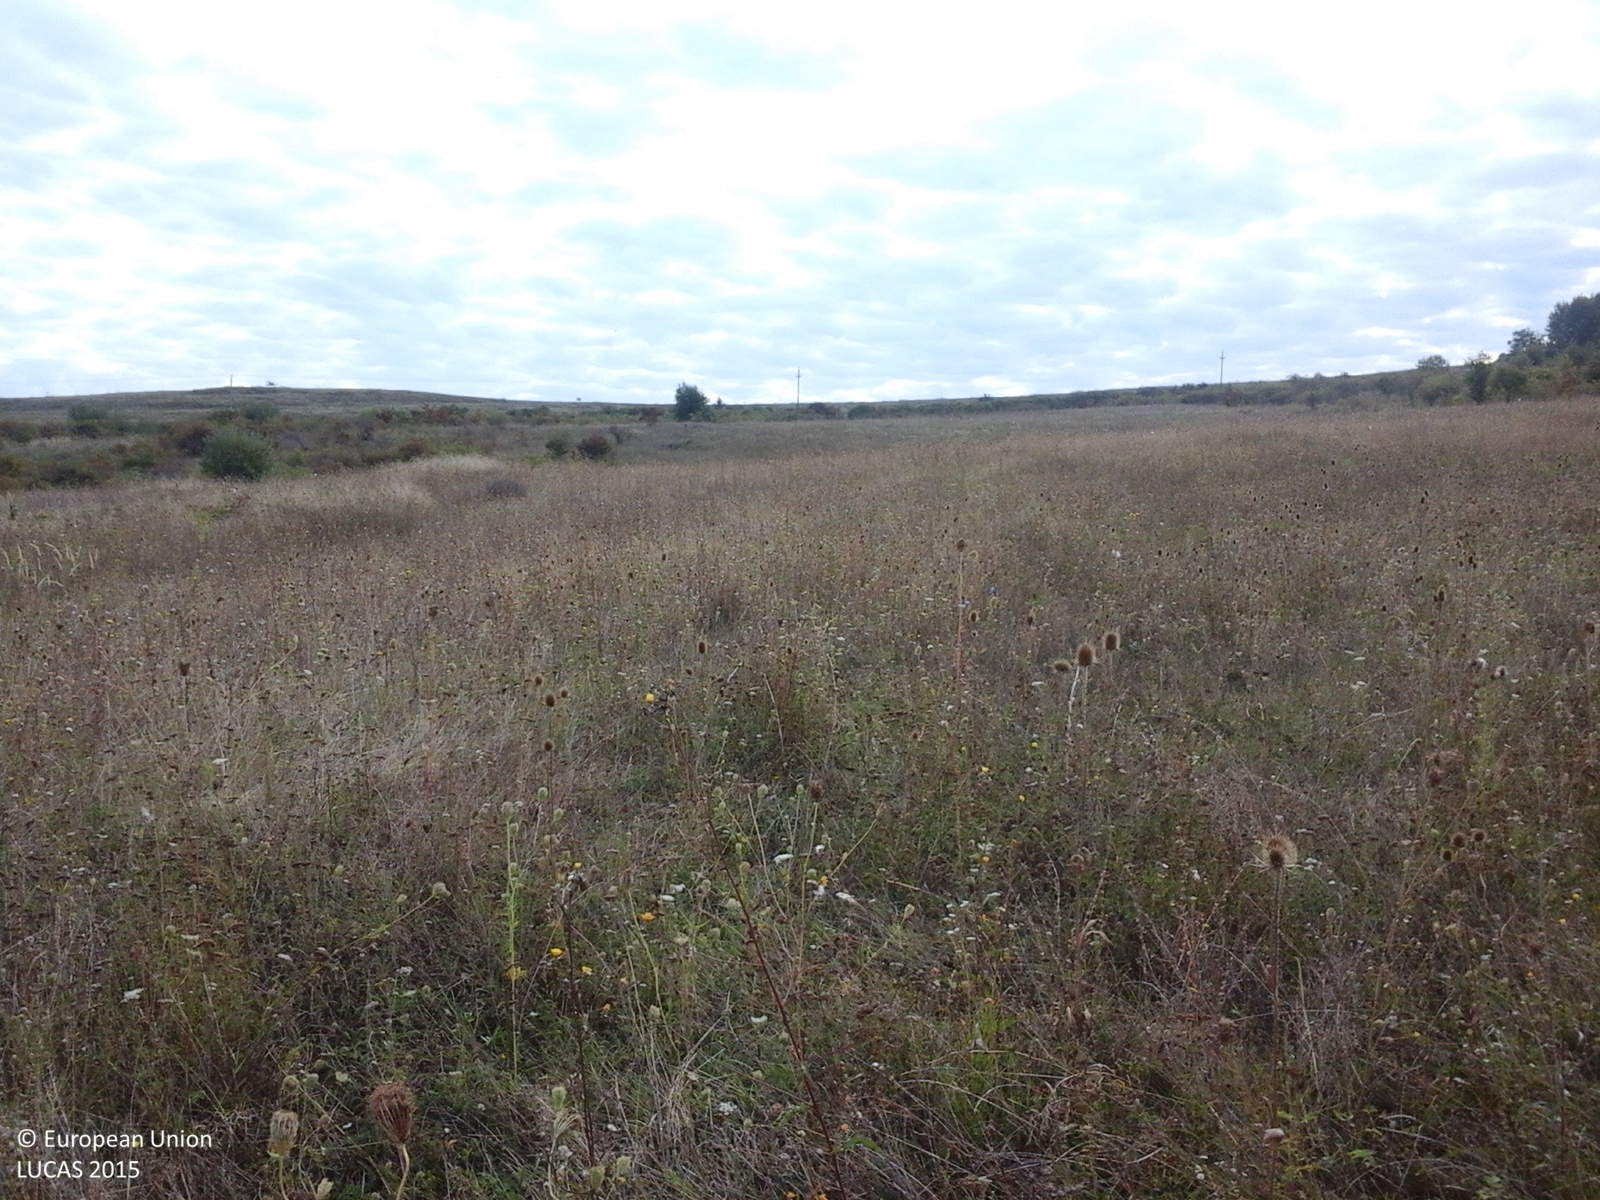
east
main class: Grassland
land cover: Grassland without tree/shrub cover
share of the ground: > 75 %
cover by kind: herbaceous plants 100 %
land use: Agriculture (excluding fallow land and kitchen gardens)
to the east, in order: Grassland without tree/shrub cover; Tracks; Spontaneously vegetated surfaces
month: September
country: RO
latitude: 47.4008
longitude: 23.2529
